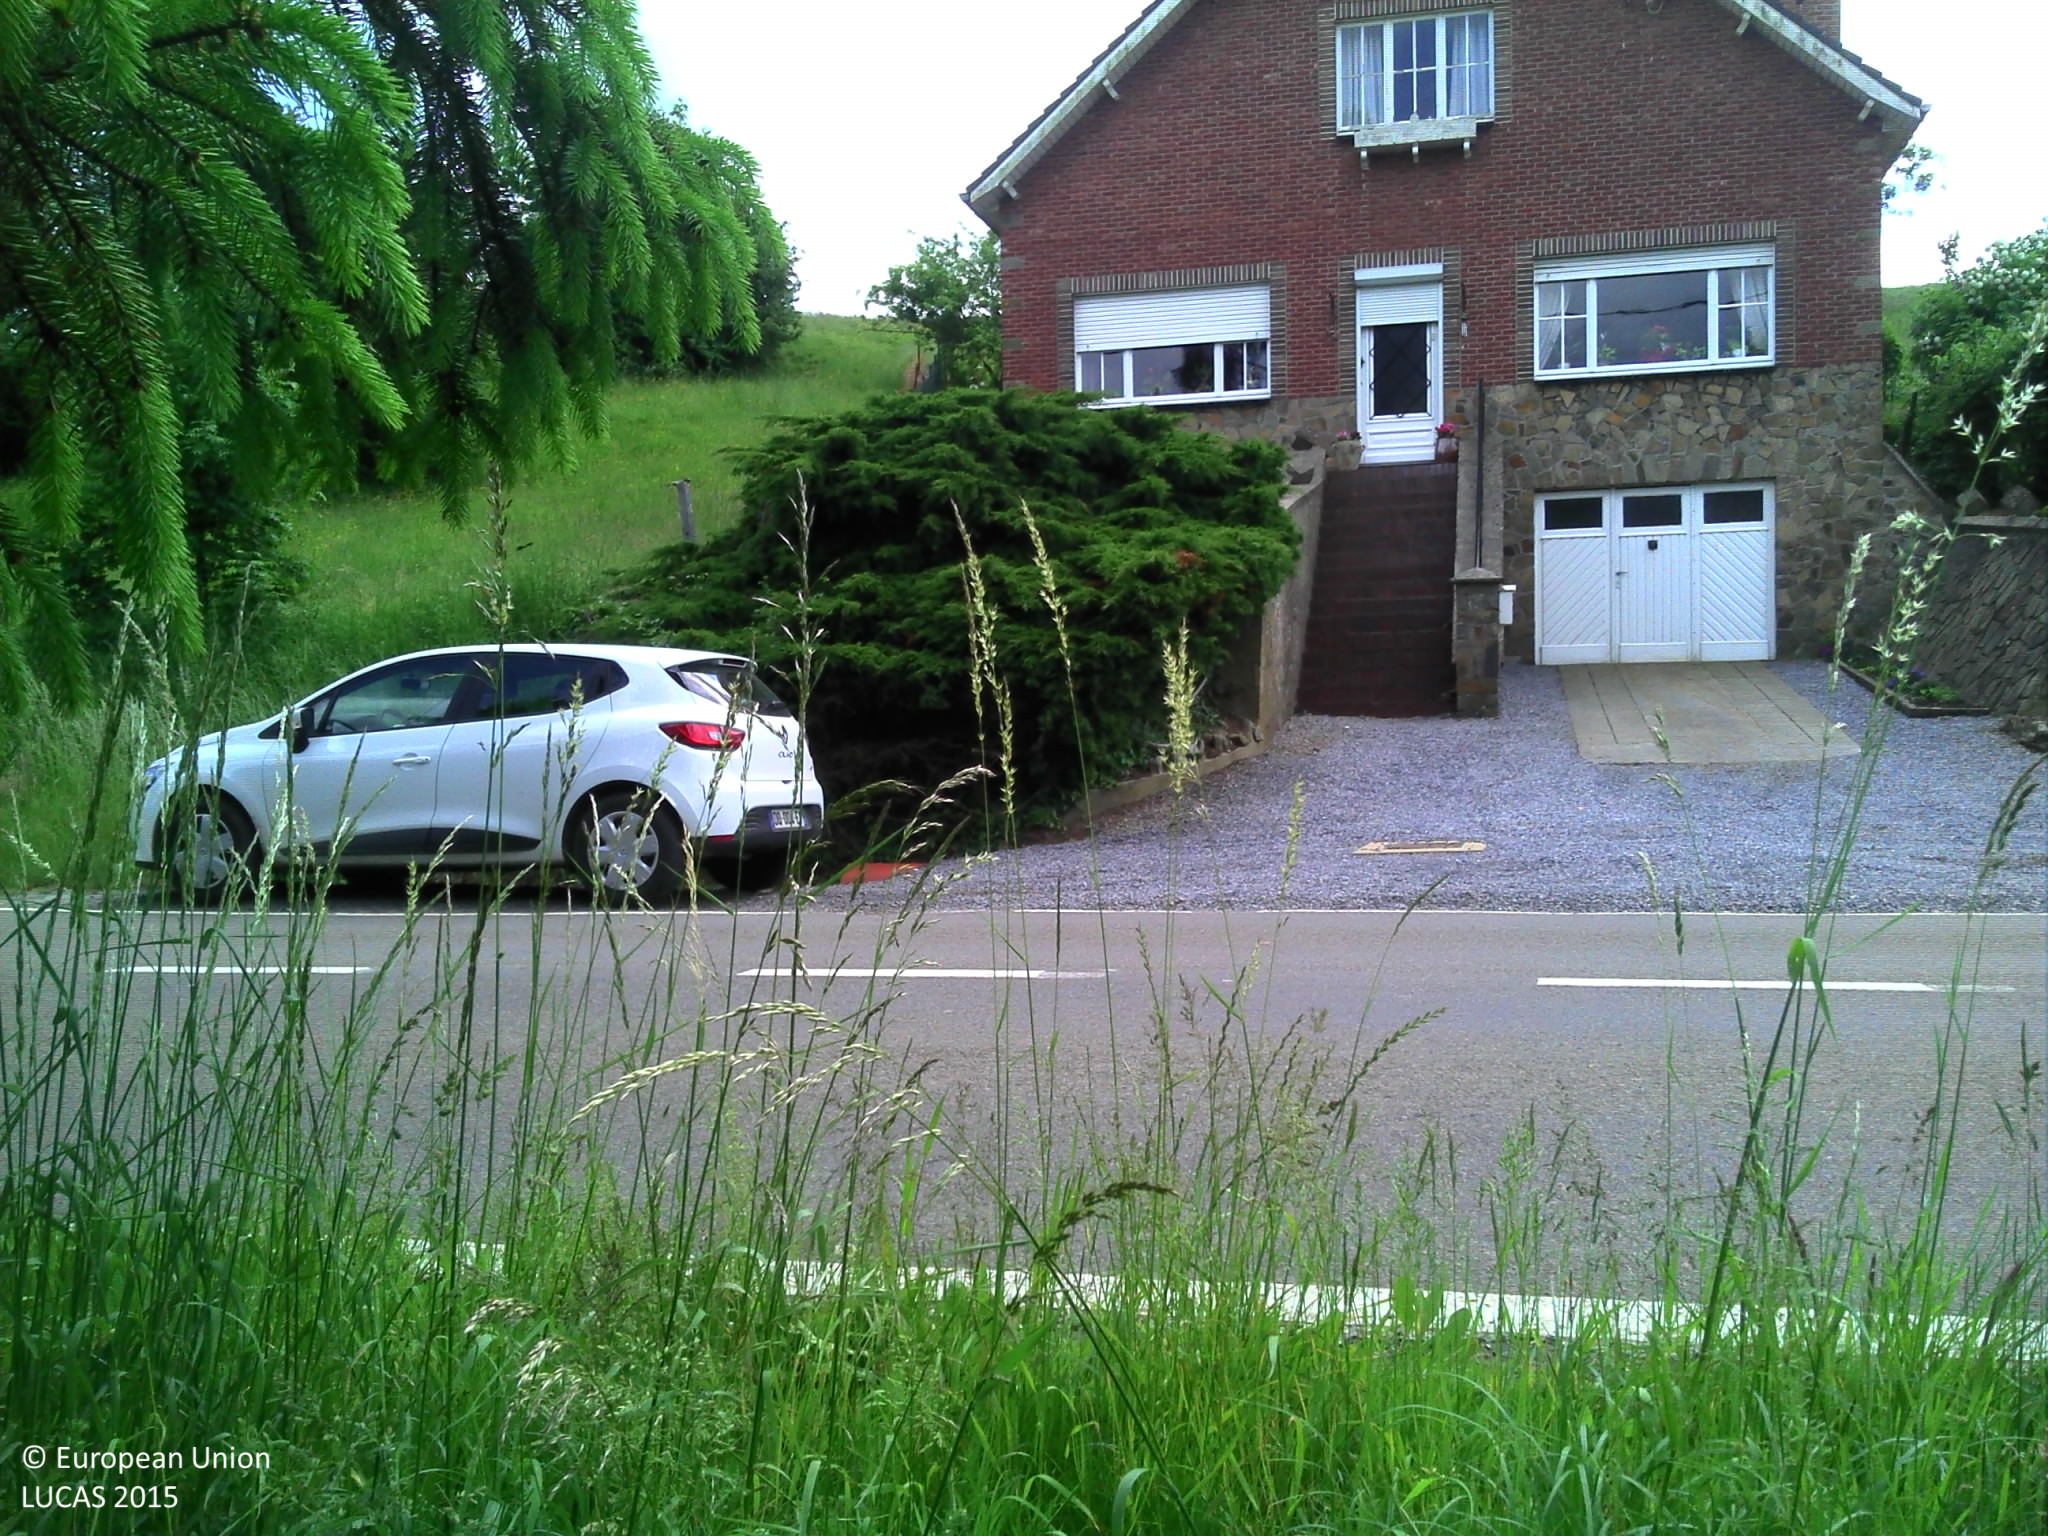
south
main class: Grassland
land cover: Grassland with sparse tree/shrub cover
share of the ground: > 75 %
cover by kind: herbaceous plants 95 %, broadleaved forest trees 5 %
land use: Agriculture (excluding fallow land and kitchen gardens)
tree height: > 5 m
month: June
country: BE
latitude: 50.5485
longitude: 5.1285
